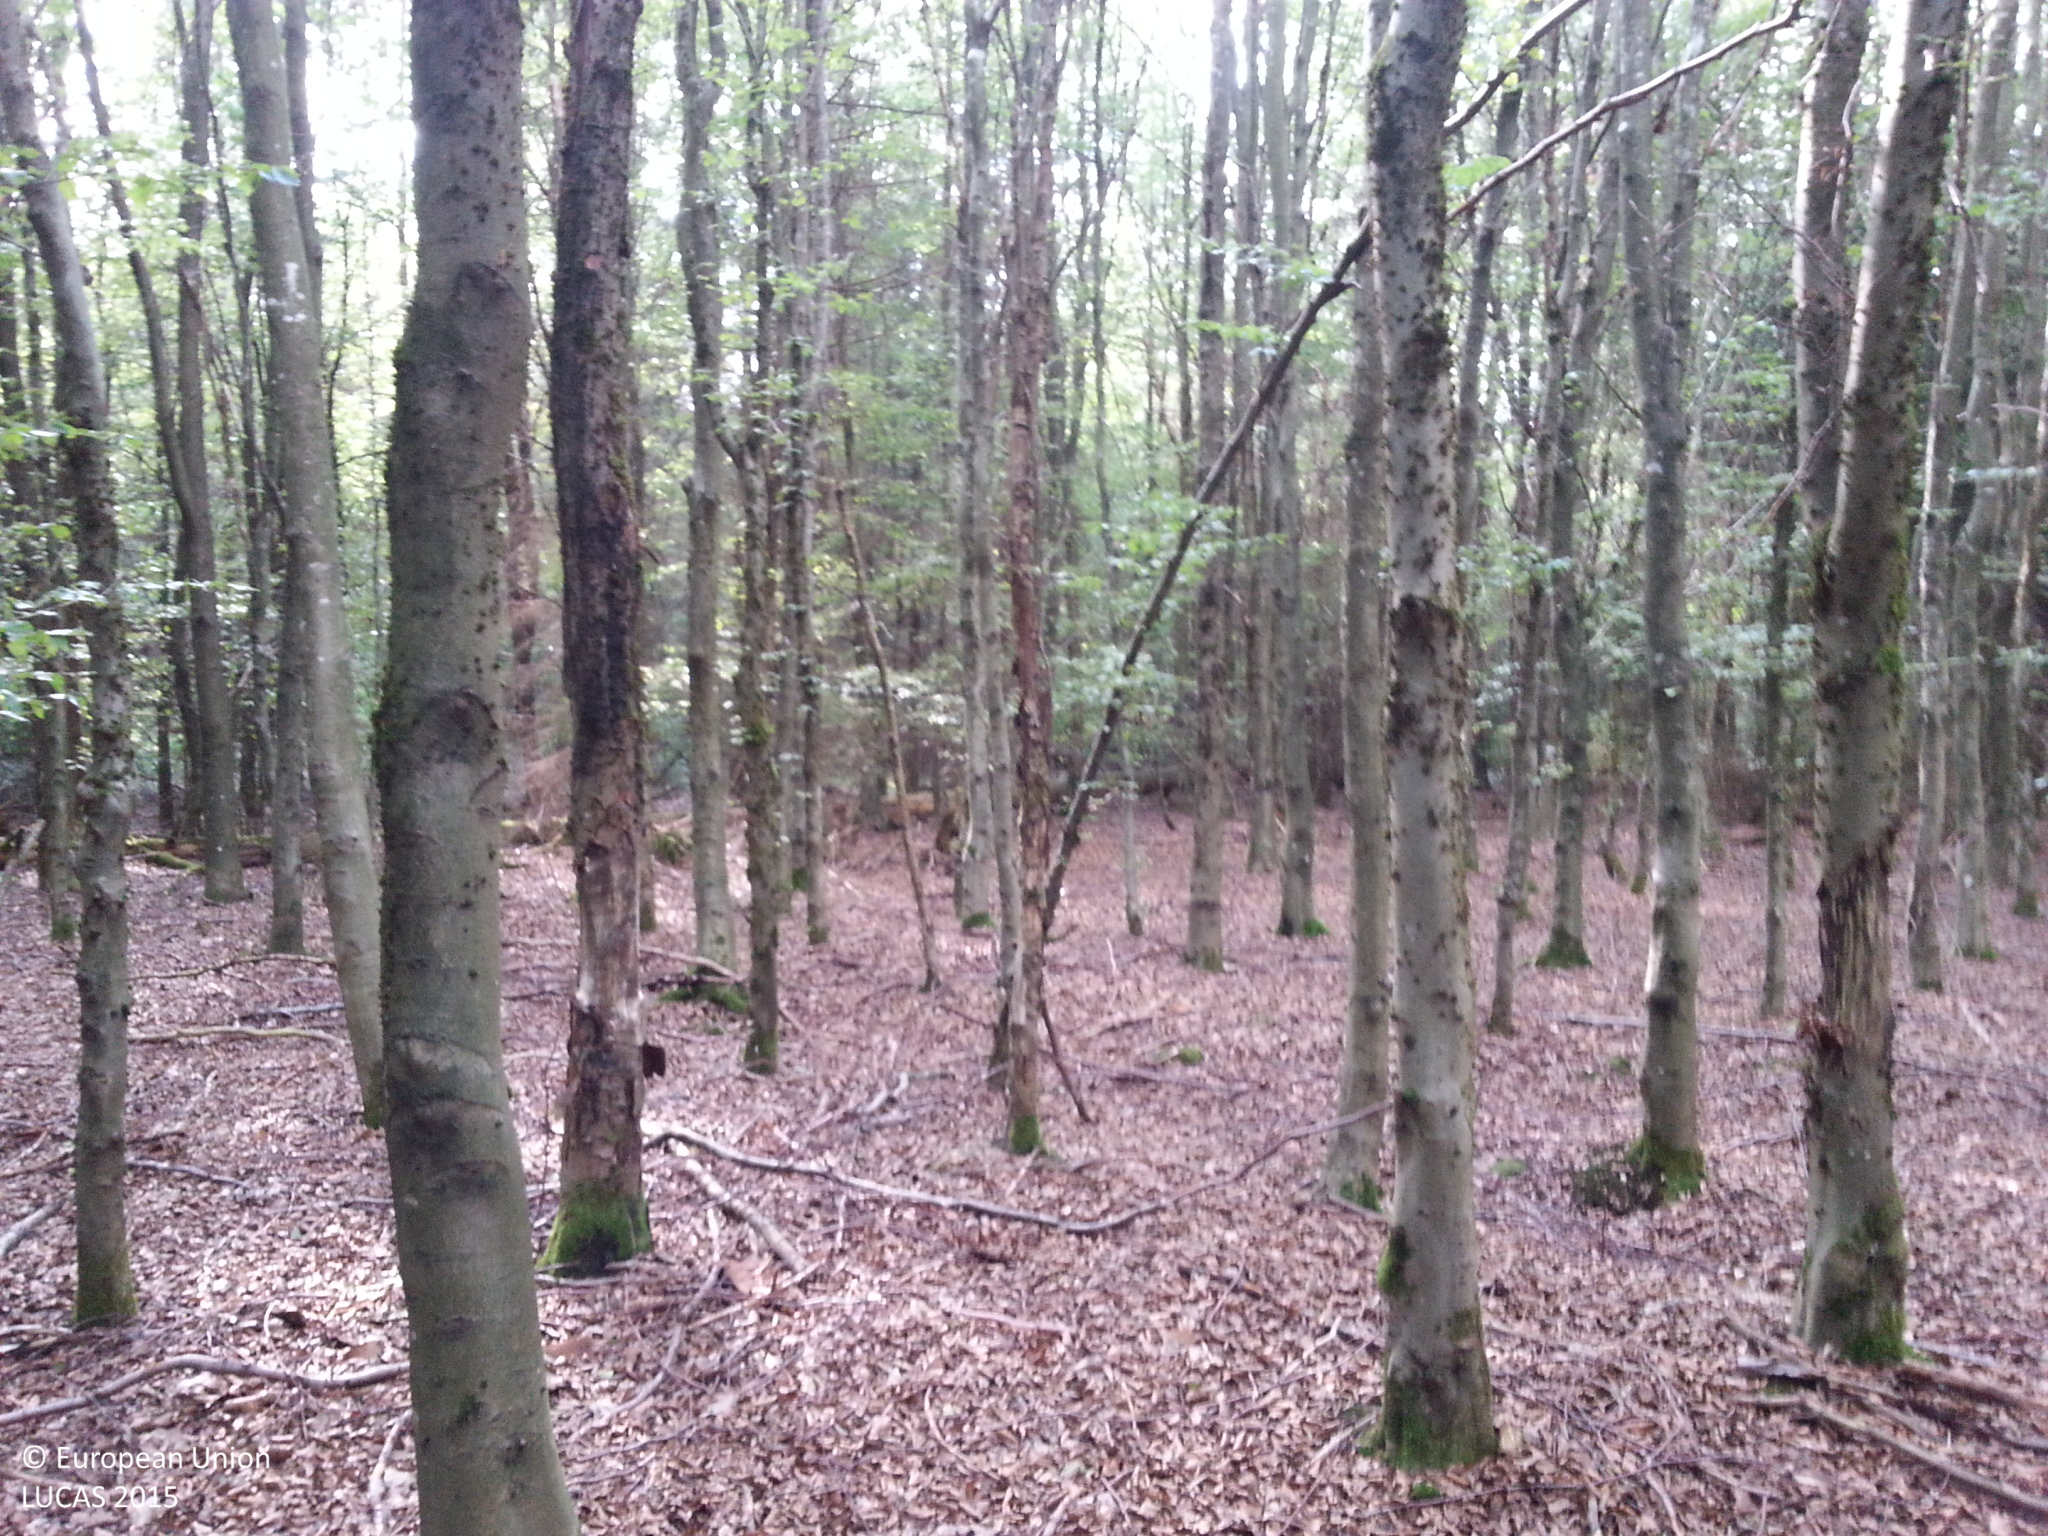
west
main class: Woodland
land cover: Broadleaved woodland
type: beech forest
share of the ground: > 75 %
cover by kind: broadleaved forest trees 85 %, unconsolidated bare surface 15 %
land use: Forestry
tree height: > 5 m
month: September
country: DE
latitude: 49.5339
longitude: 9.1851
